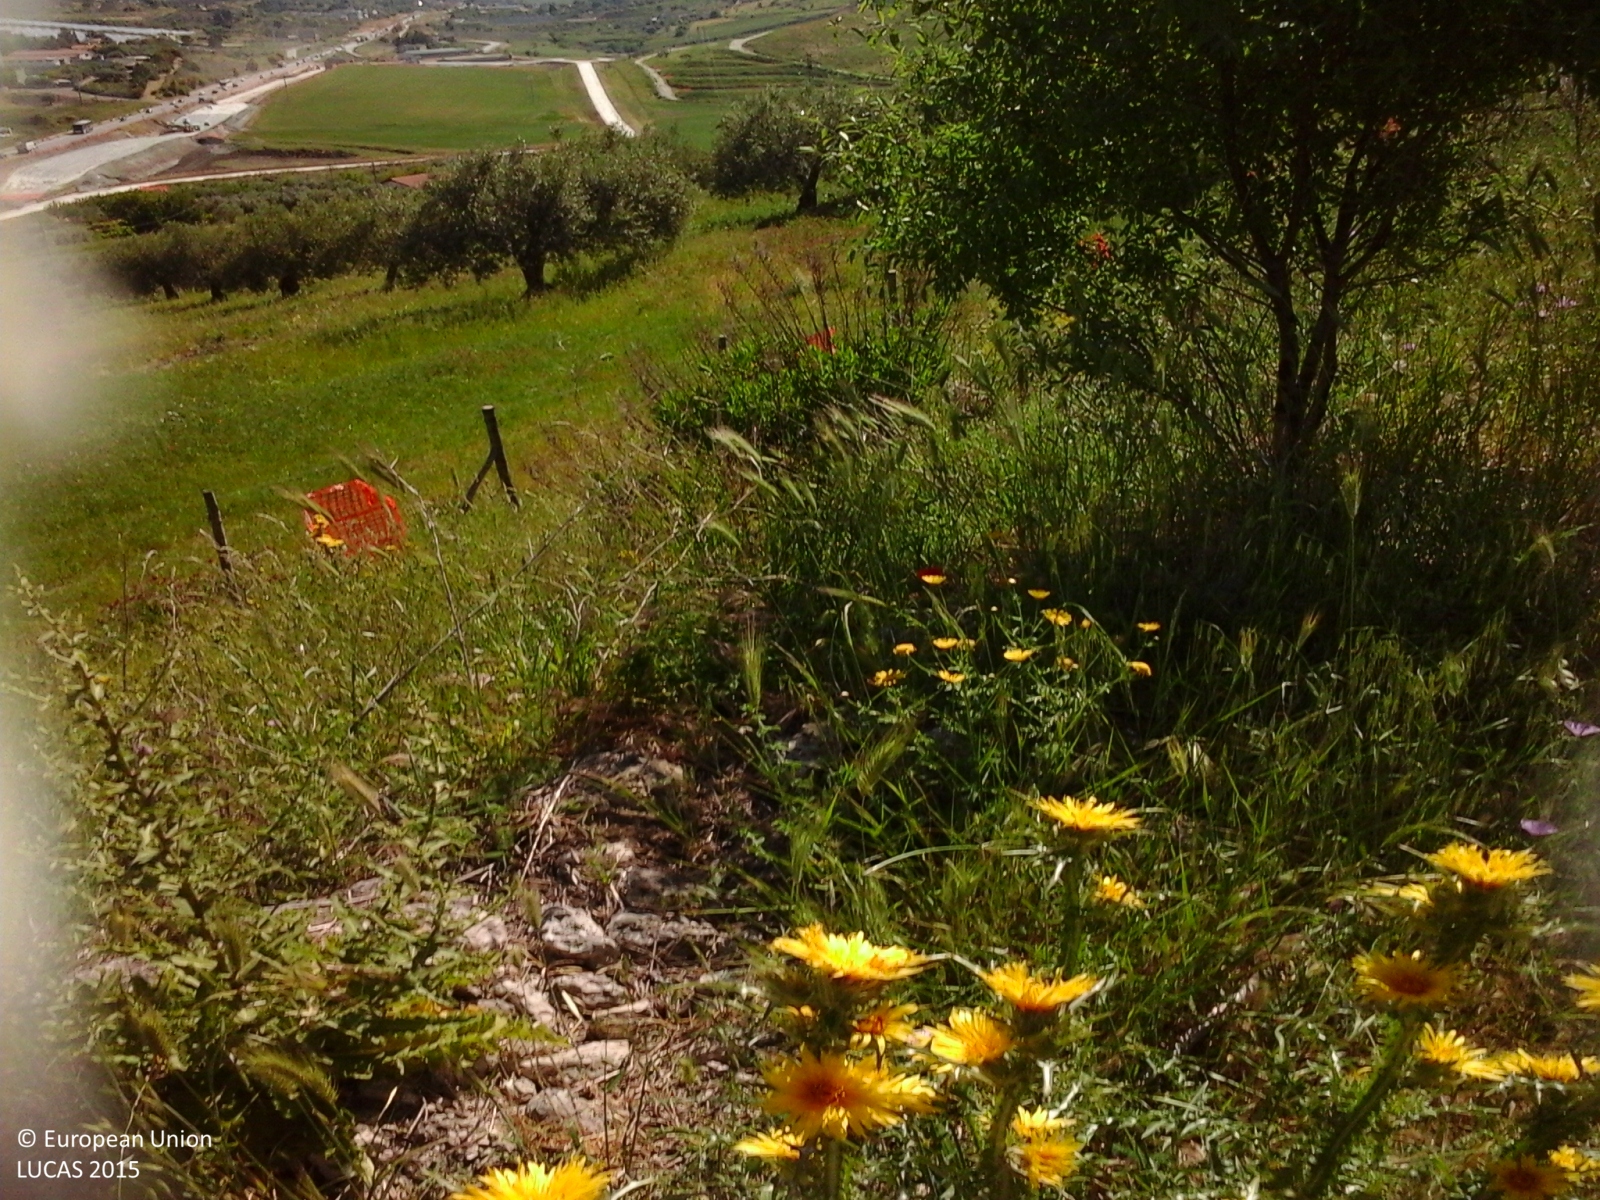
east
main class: Cropland
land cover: Olive groves
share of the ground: > 75 %
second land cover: Spontaneously vegetated surfaces
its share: > 75 %
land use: Agriculture (excluding fallow land and kitchen gardens)
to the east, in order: Olive groves; Spontaneously vegetated surfaces; Electric lines; Olive groves; Grass margins; Temporary grasslands; Grass margins; Olive groves
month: May
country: IT
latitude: 37.4470
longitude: 13.9602
